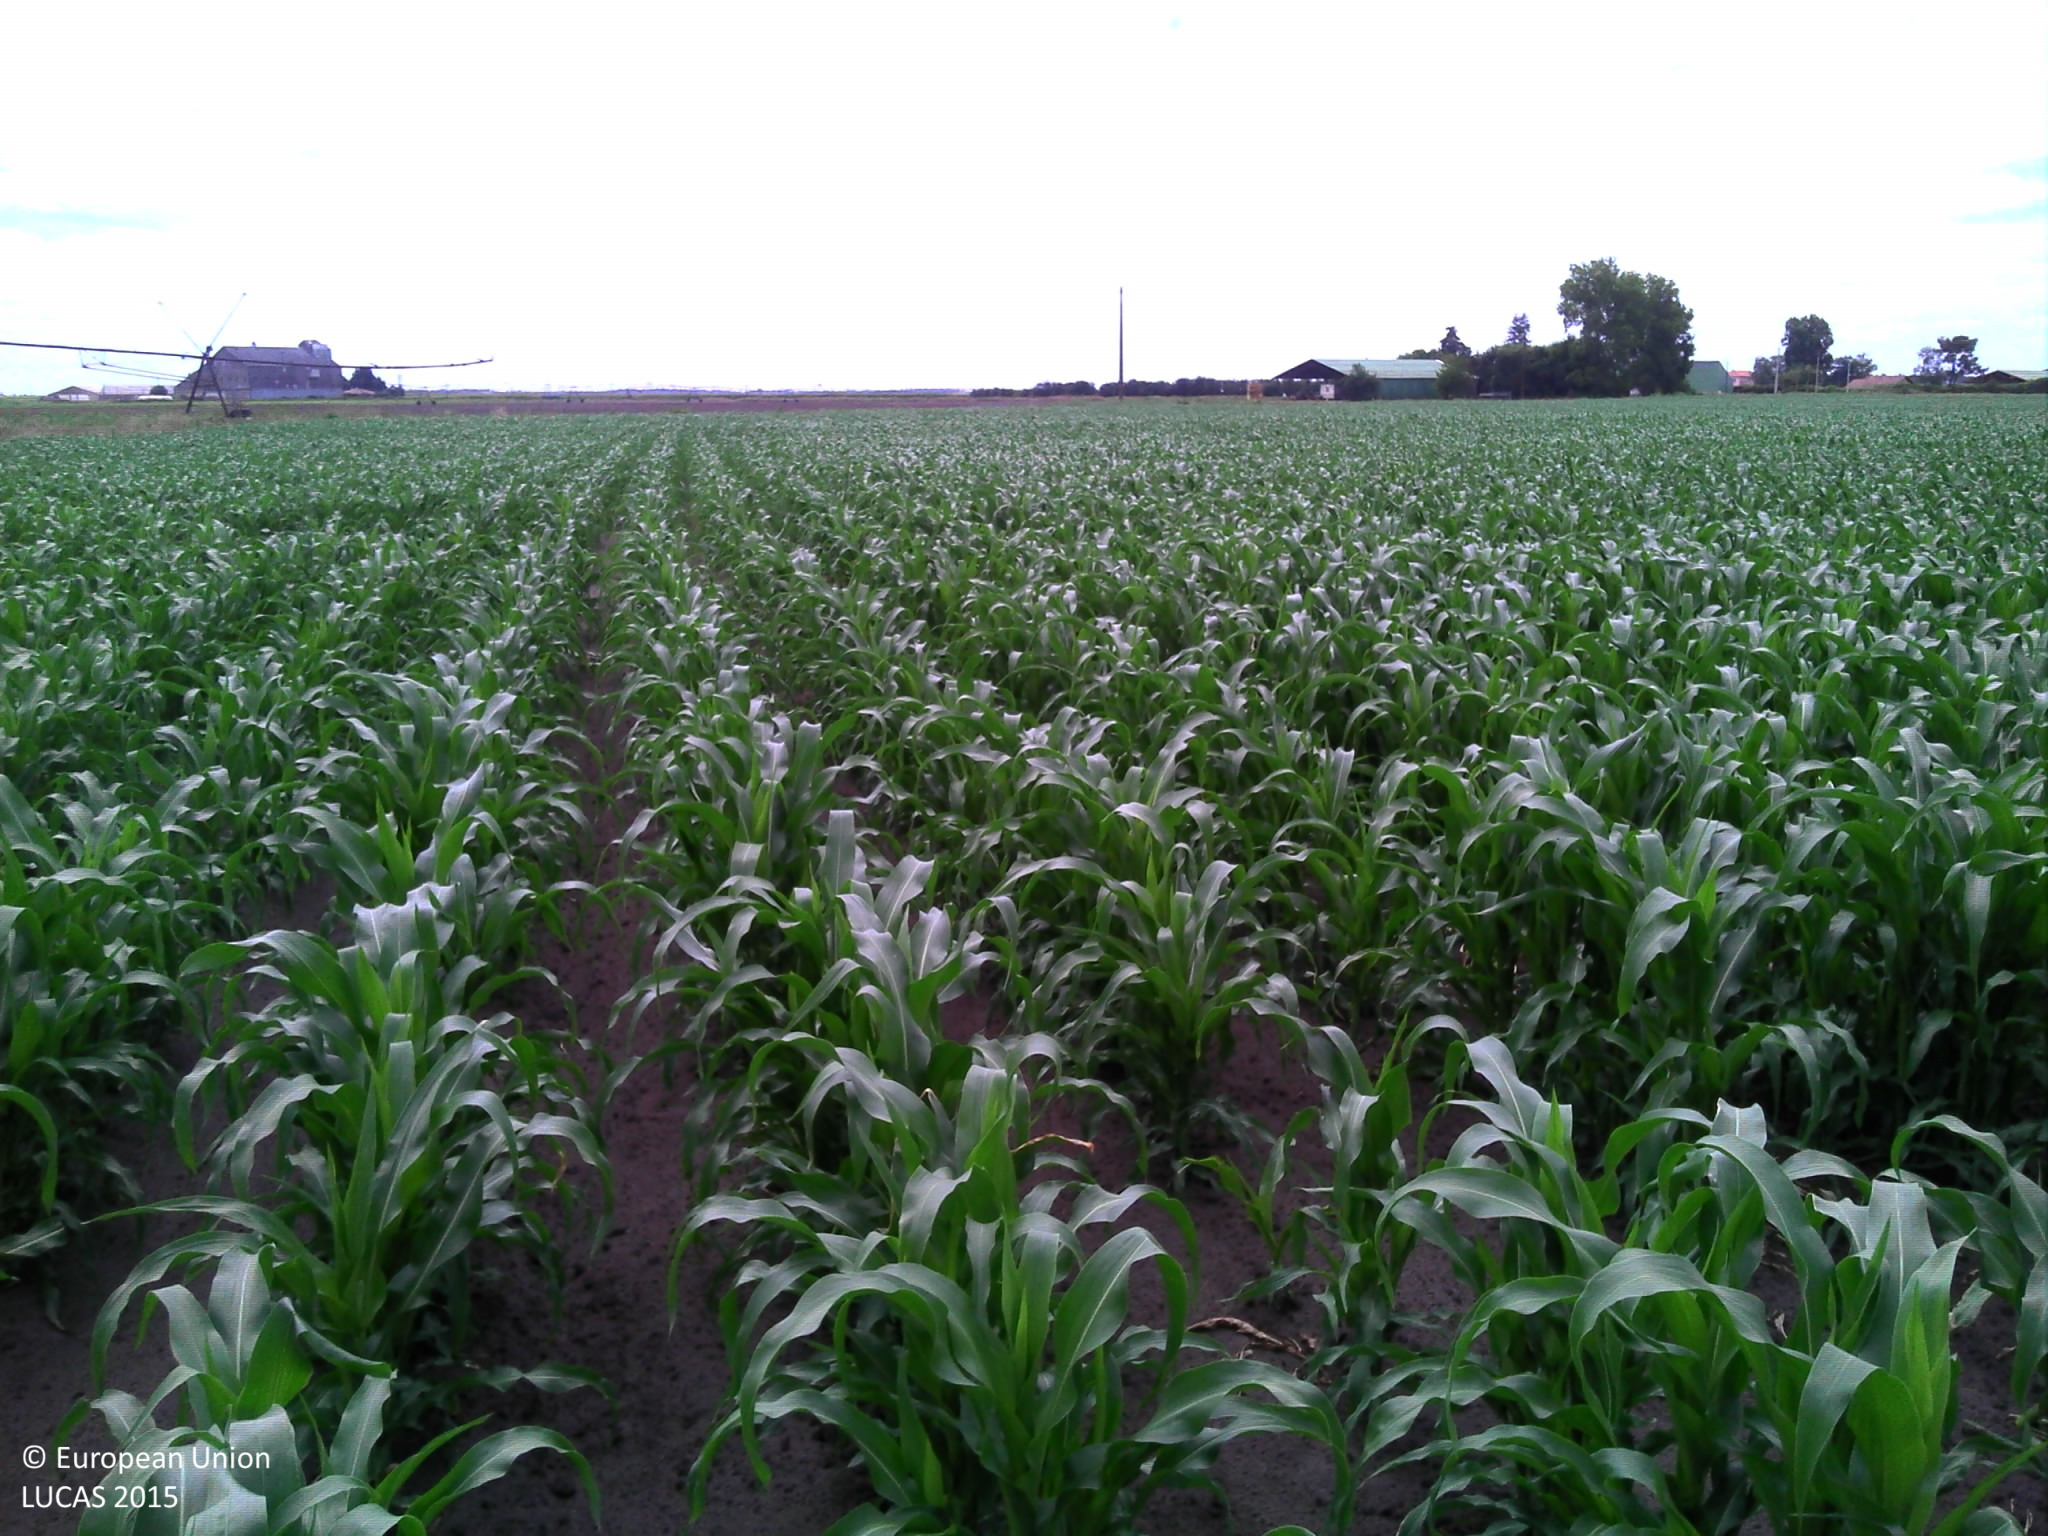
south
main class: Cropland
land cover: Maize
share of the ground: > 75 %
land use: Agriculture (excluding fallow land and kitchen gardens)
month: July
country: FR
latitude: 44.1048
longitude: -0.8730
